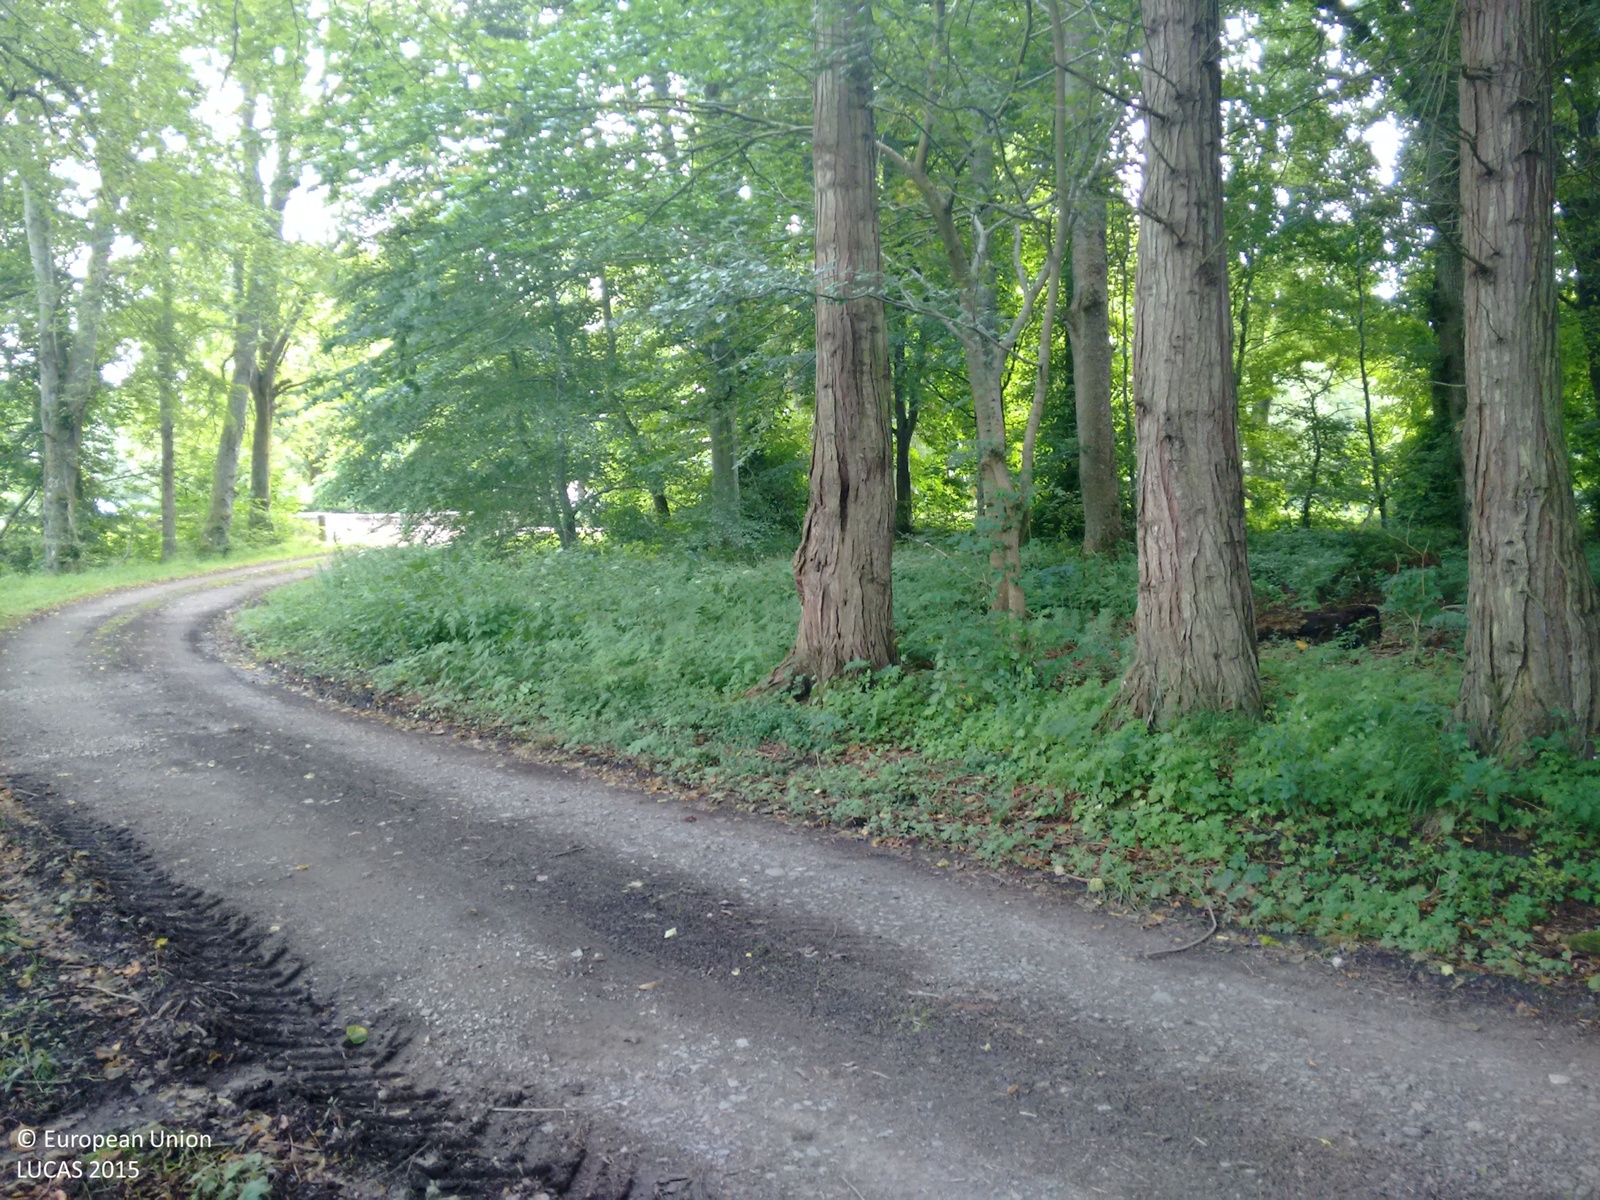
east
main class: Woodland
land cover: Broadleaved woodland
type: floodplain forest
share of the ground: > 75 %
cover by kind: broadleaved forest trees 95 %, coniferous forest trees 5 %
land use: Semi-natural and natural areas not in use
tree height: > 5 m
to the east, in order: Broadleaved woodland; Rivers and streams; Broadleaved woodland; Paved roads, cycling and walking lanes; Broadleaved woodland; Paved roads, cycling and walking lanes; Broadleaved woodland; Rivers and streams; Spruce dominated mixed woodland; Fences; Common wheat; Shrubland without tree cover
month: August
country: GB
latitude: 57.5686
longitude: -4.2116
